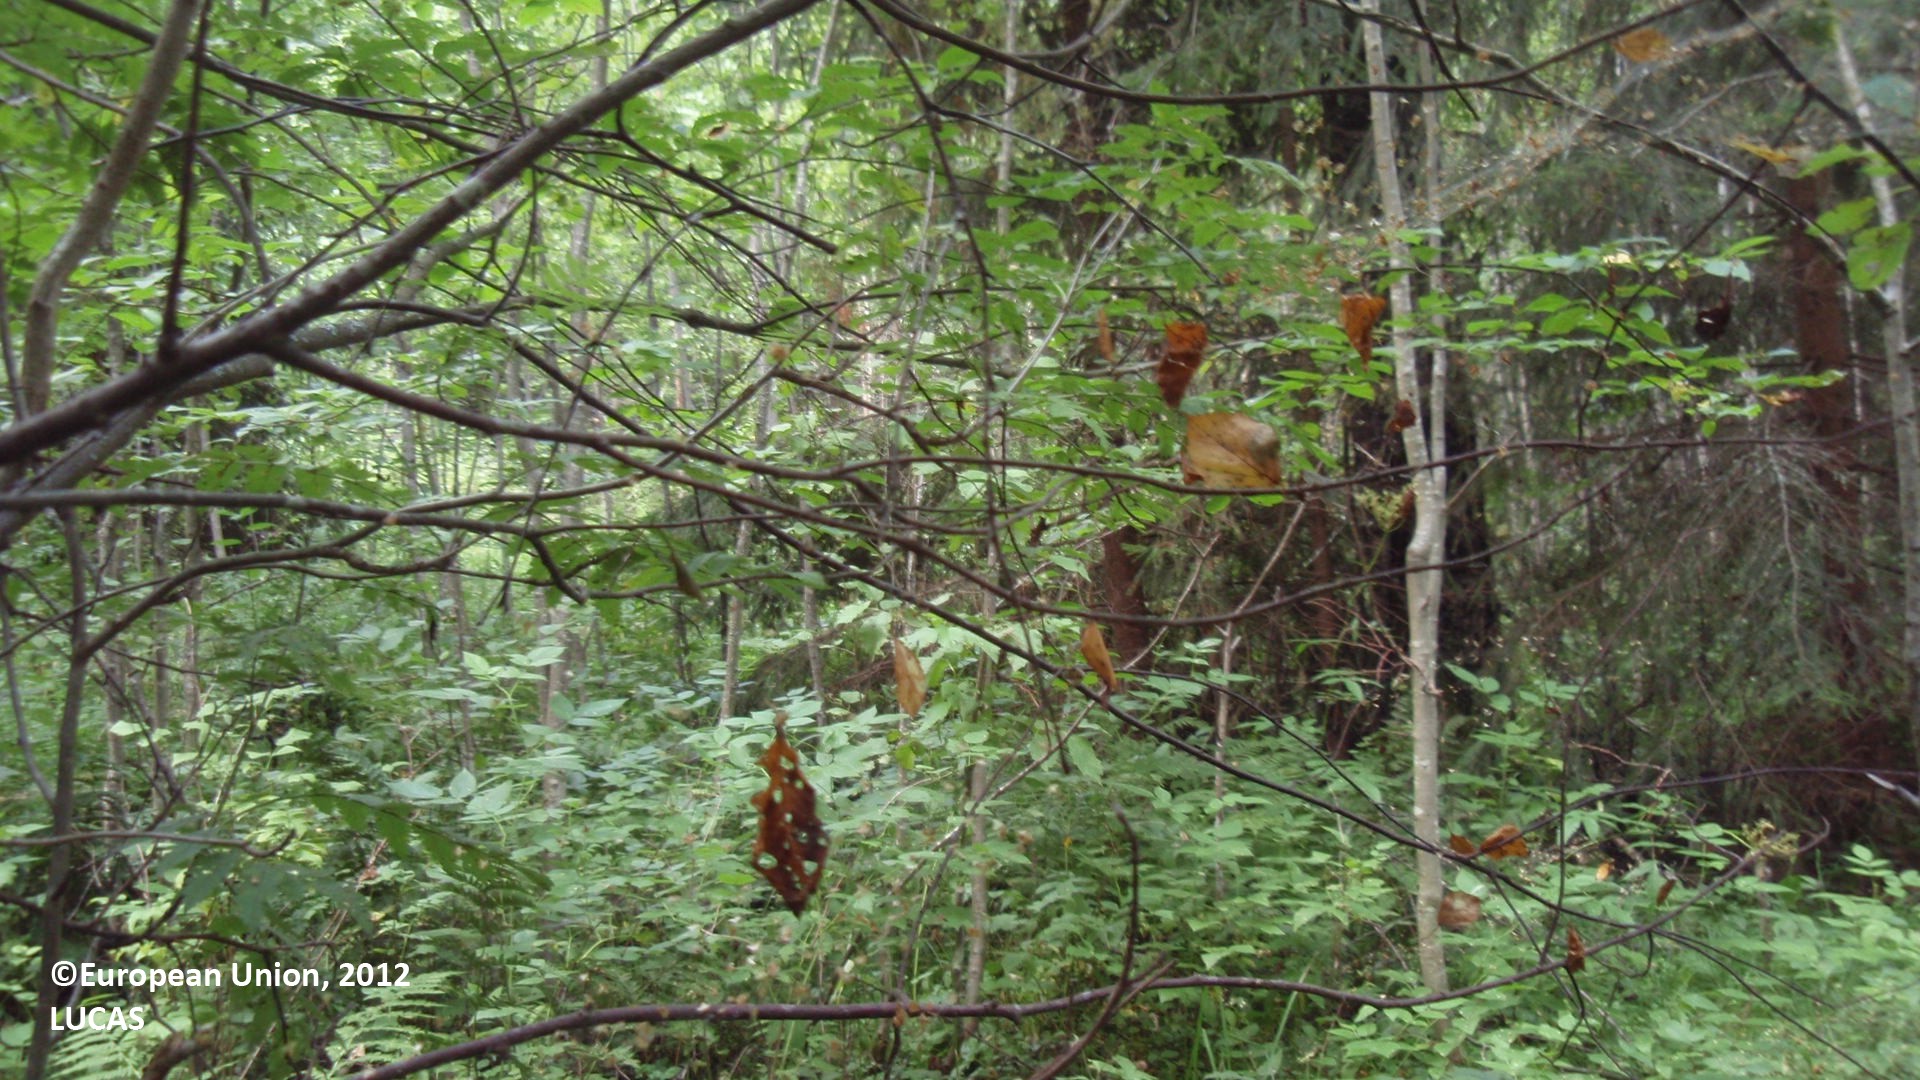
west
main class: Woodland
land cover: Broadleaved woodland
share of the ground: 50 - 75 %
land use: Forestry
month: August
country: FI
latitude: 61.0484
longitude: 27.9951
